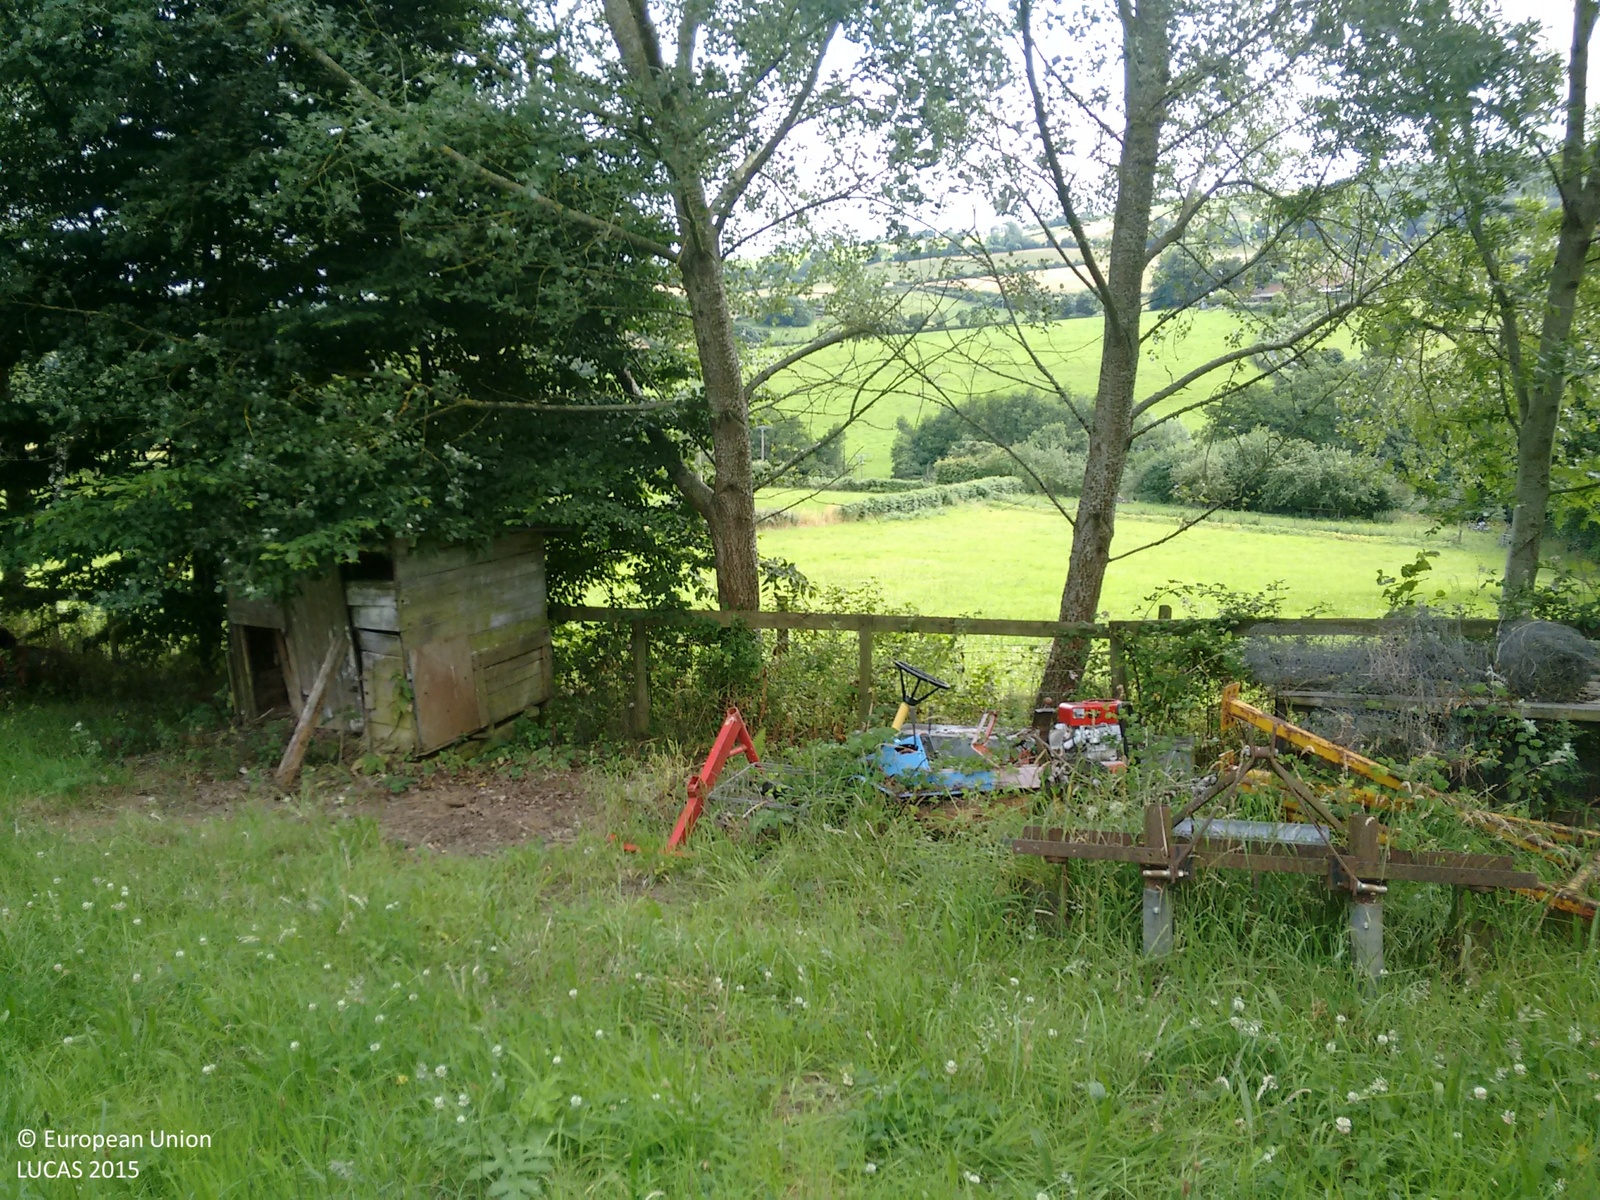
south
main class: Grassland
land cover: Grassland without tree/shrub cover
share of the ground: > 75 %
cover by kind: herbaceous plants 100 %
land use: Agriculture (excluding fallow land and kitchen gardens)
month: July
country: GB
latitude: 51.4192
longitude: -2.3591
